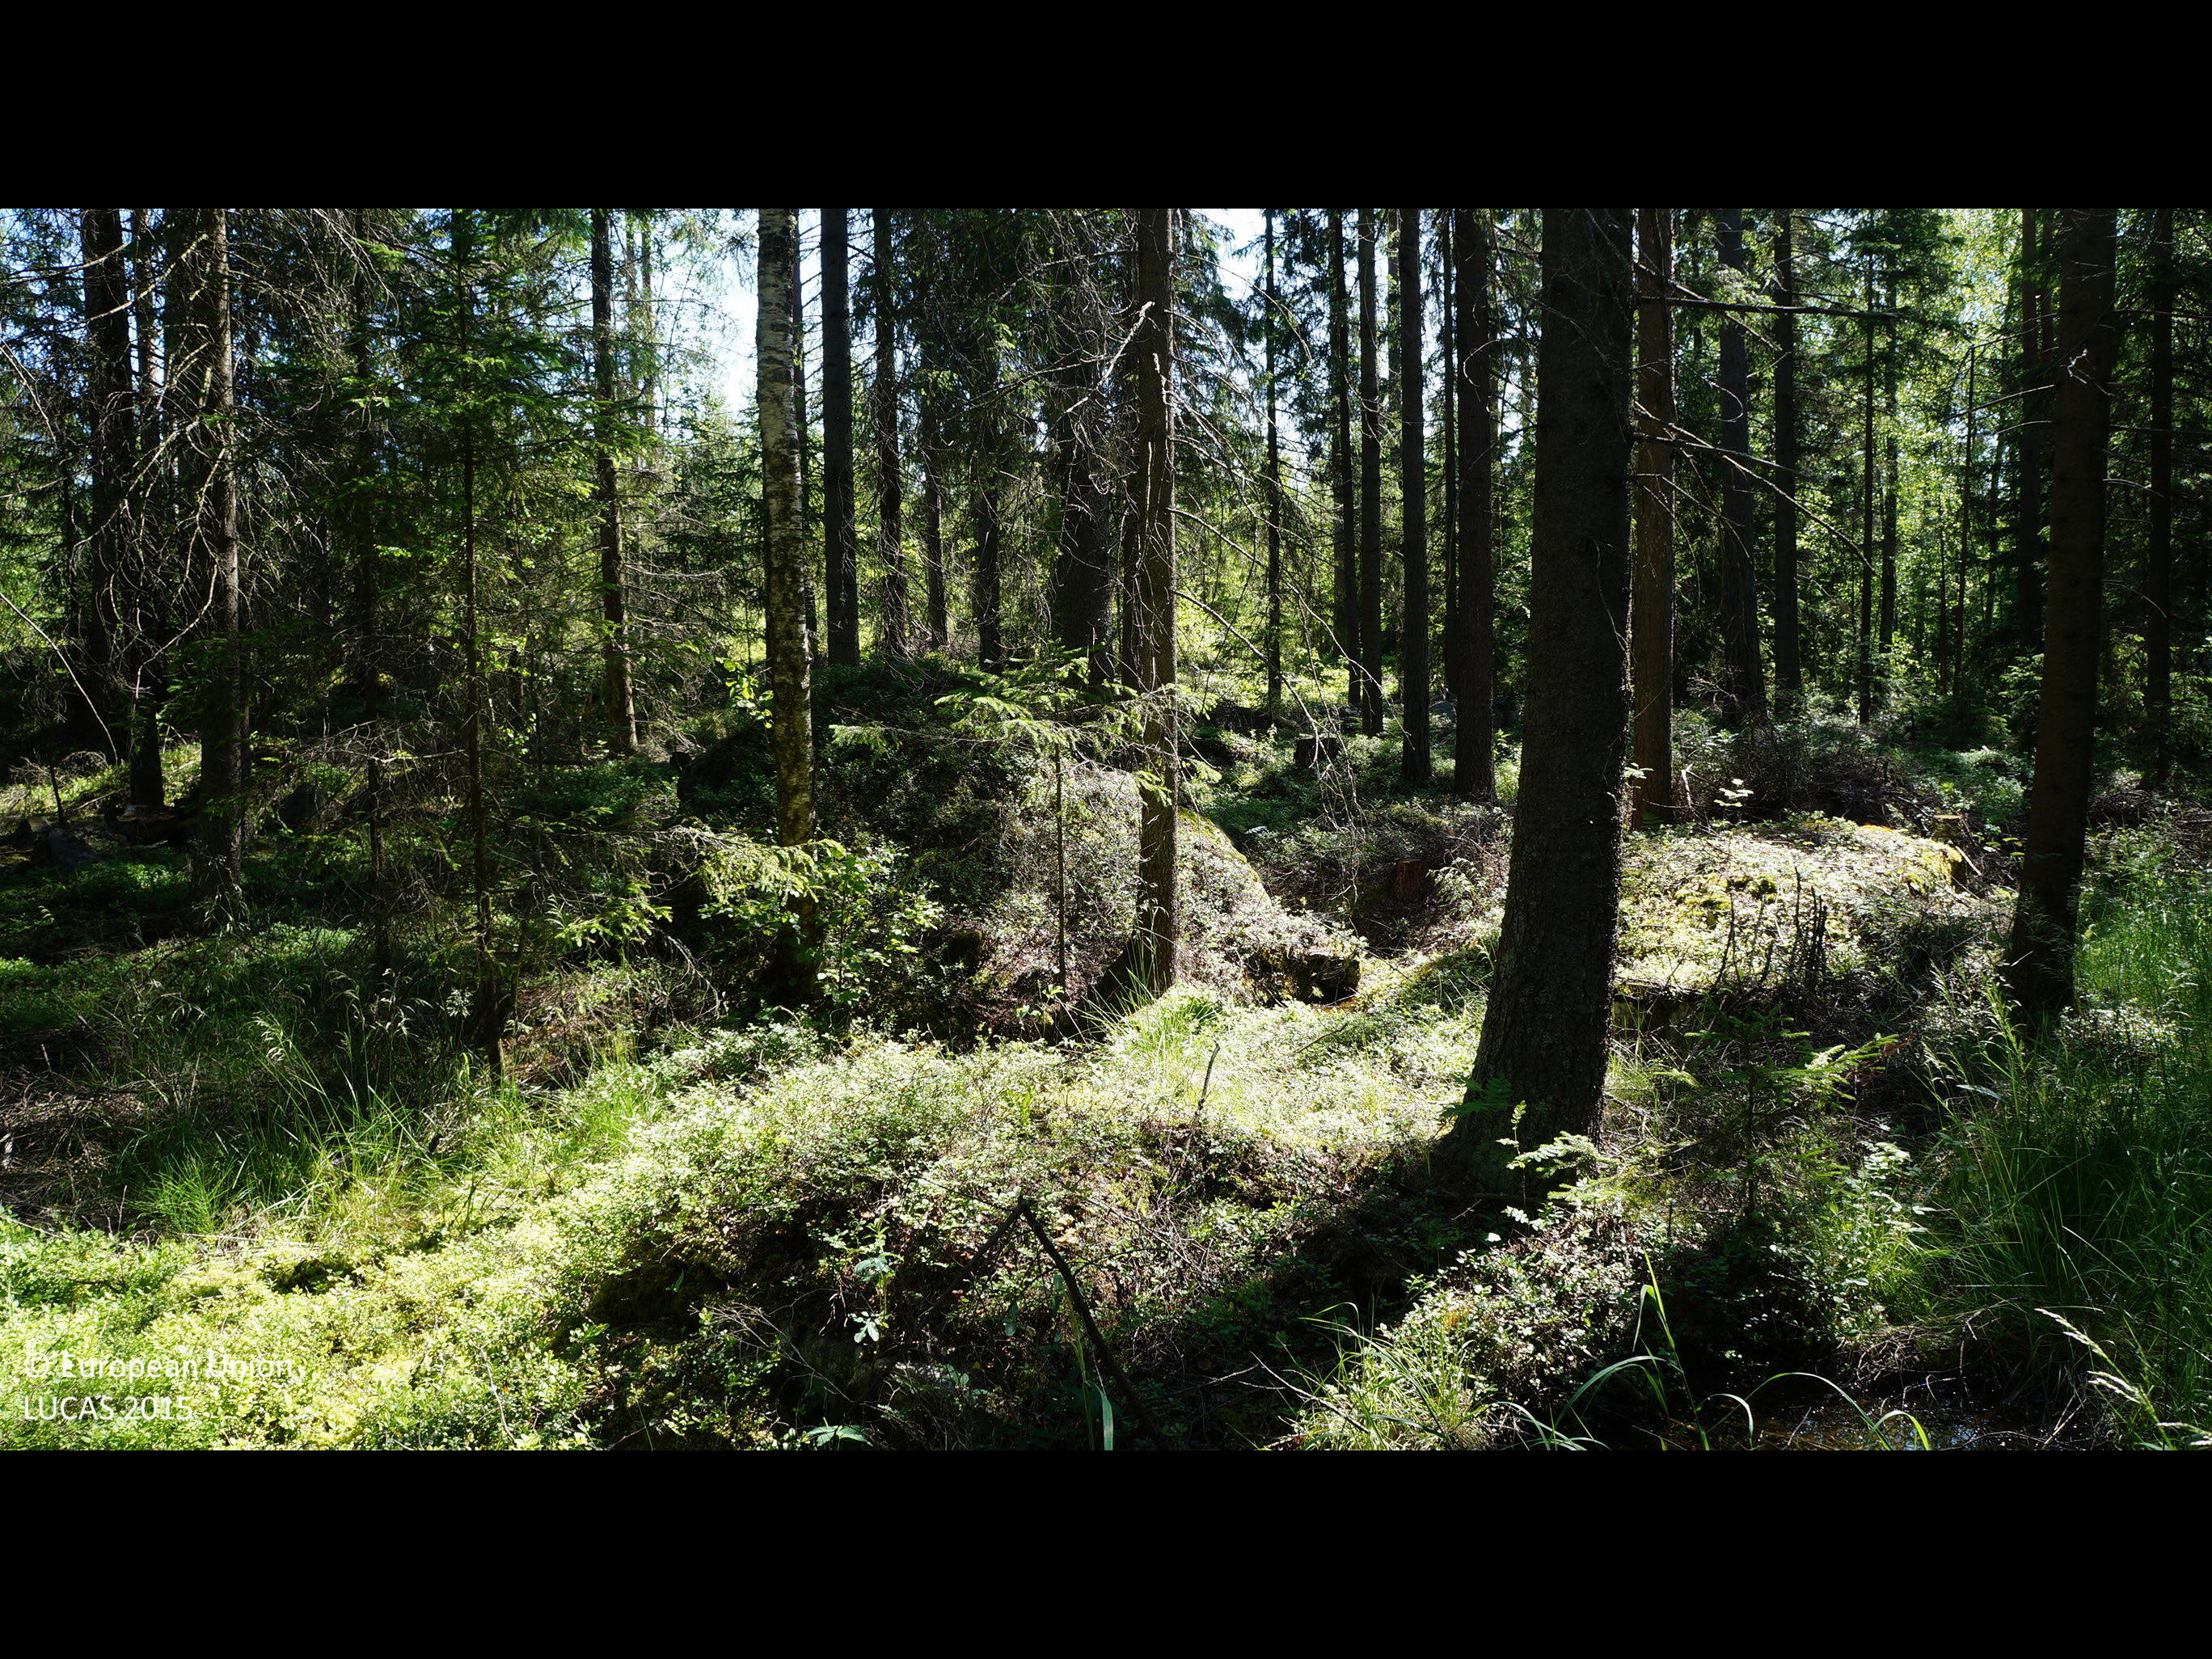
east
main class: Woodland
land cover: Spruce dominated mixed woodland
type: boreal forest
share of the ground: 50 - 75 %
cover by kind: coniferous forest trees 40 %, shrubs 25 %, broadleaved forest trees 20 %, herbaceous plants 15 %
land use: Forestry
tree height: > 5 m
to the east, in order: Spruce dominated mixed woodland; Tracks; Spontaneously vegetated surfaces; Other mixed woodland; Pine dominated mixed woodland; Pine dominated coniferous woodland; Spontaneously vegetated surfaces; Pine dominated coniferous woodland
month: July
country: FI
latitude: 63.7959
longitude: 22.8986
